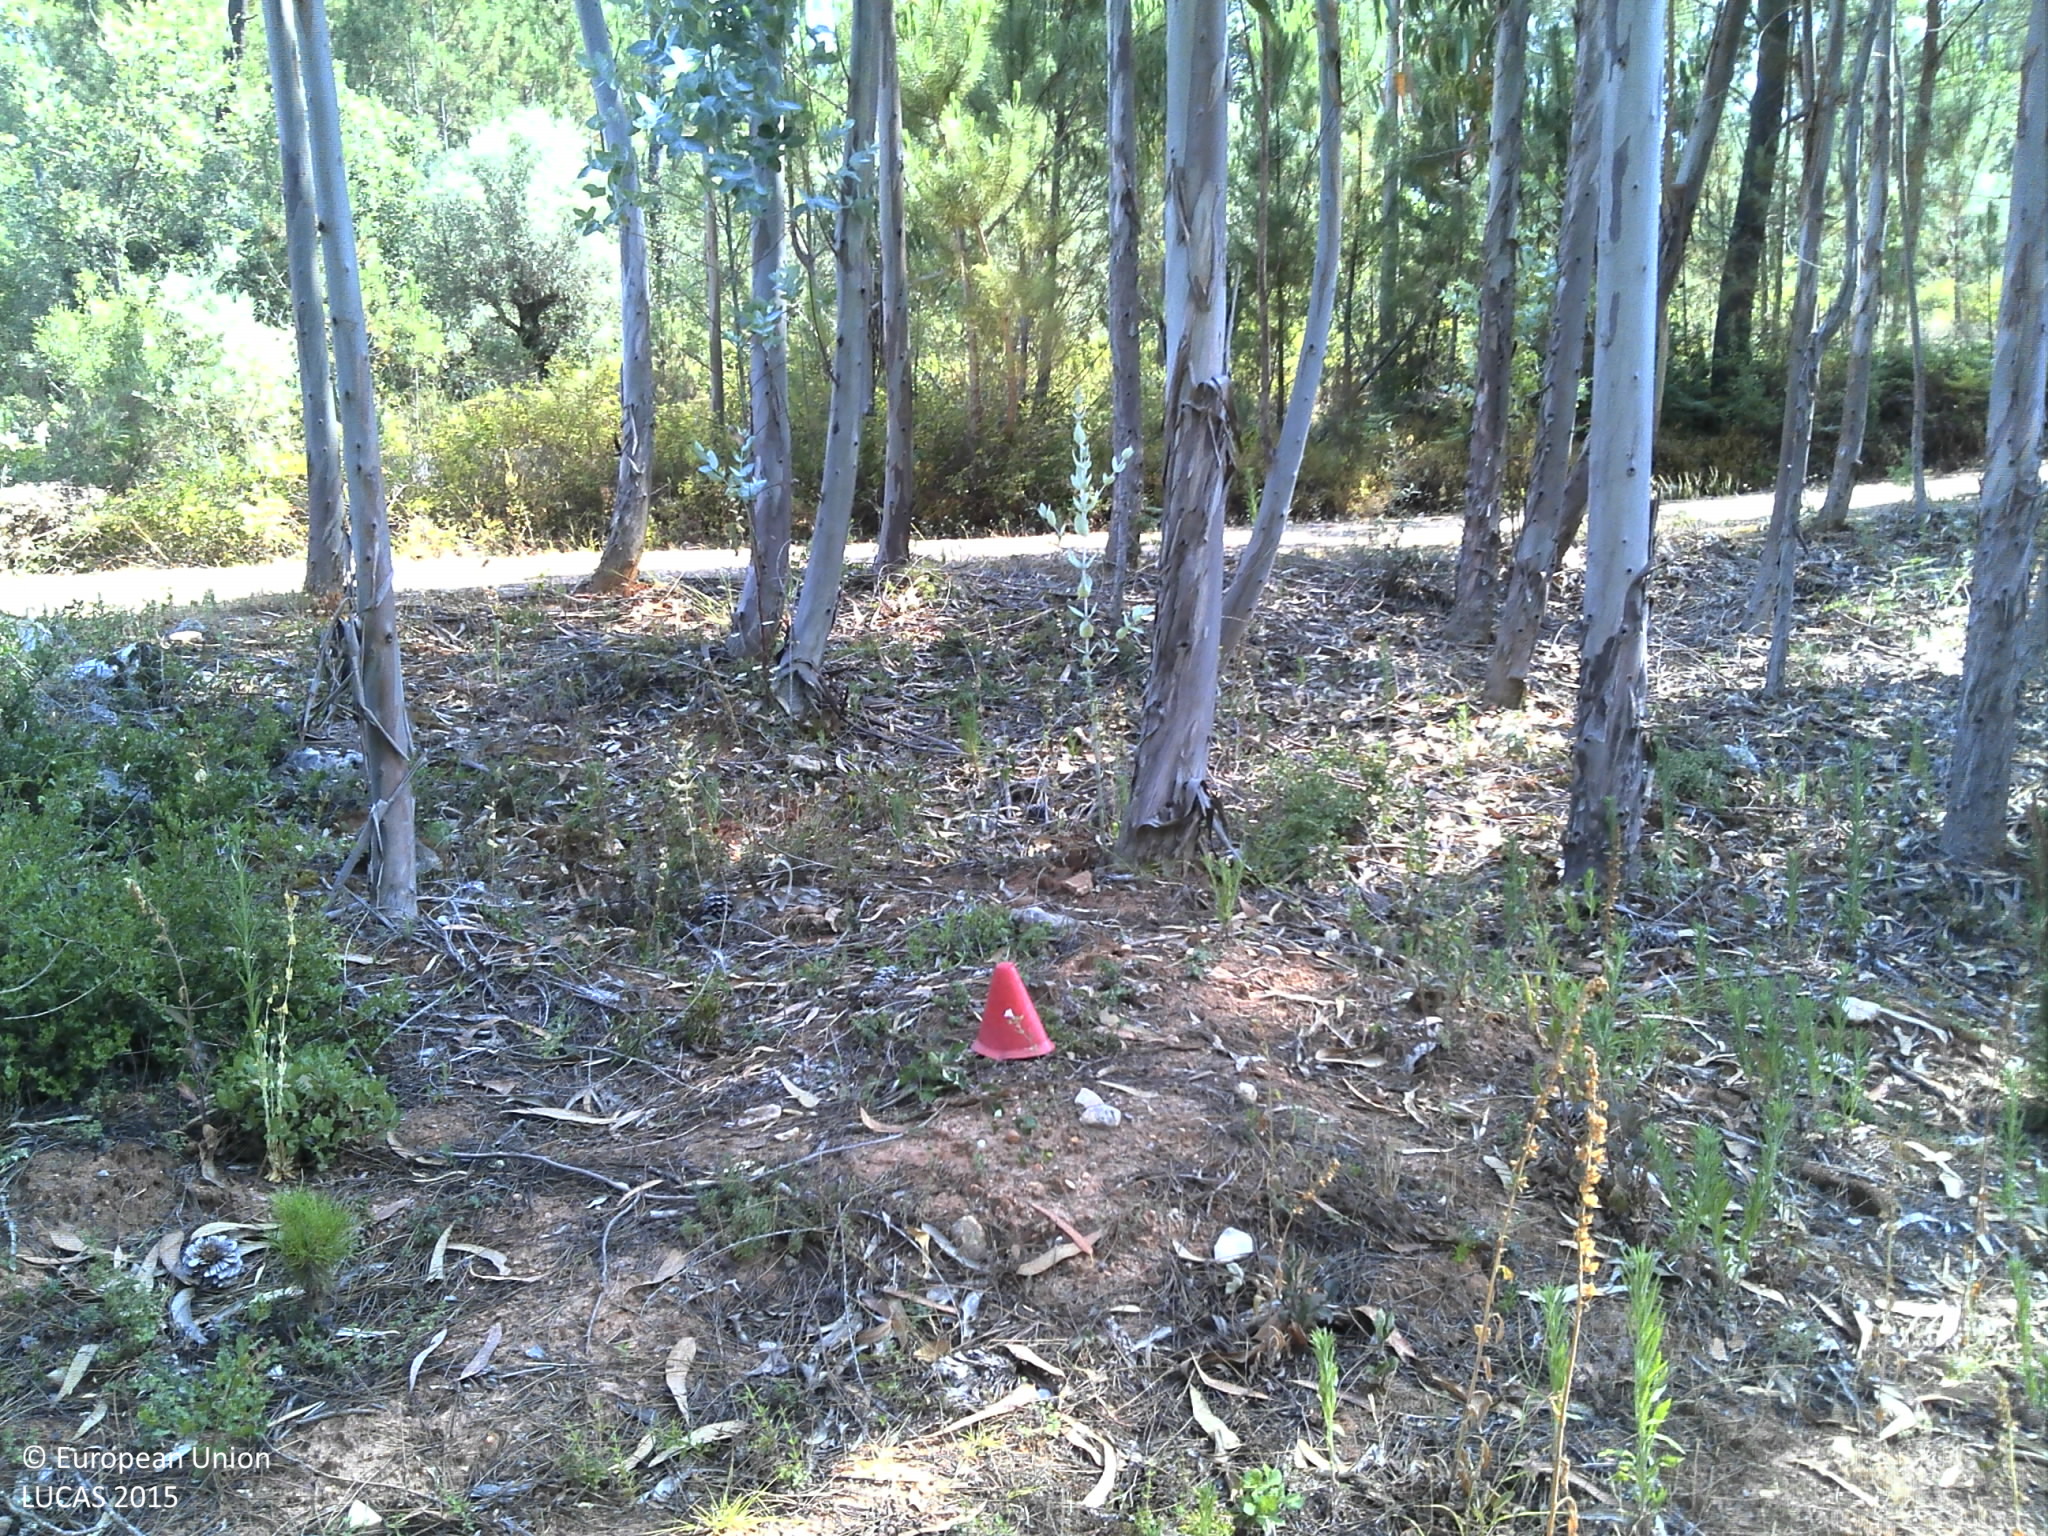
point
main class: Woodland
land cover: Broadleaved woodland
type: exotic forest
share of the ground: 50 - 75 %
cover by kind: broadleaved forest trees 55 %, unconsolidated bare surface 40 %, shrubs 5 %
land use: Forestry
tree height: > 5 m
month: July
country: PT
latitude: 39.9403
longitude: -8.4653
